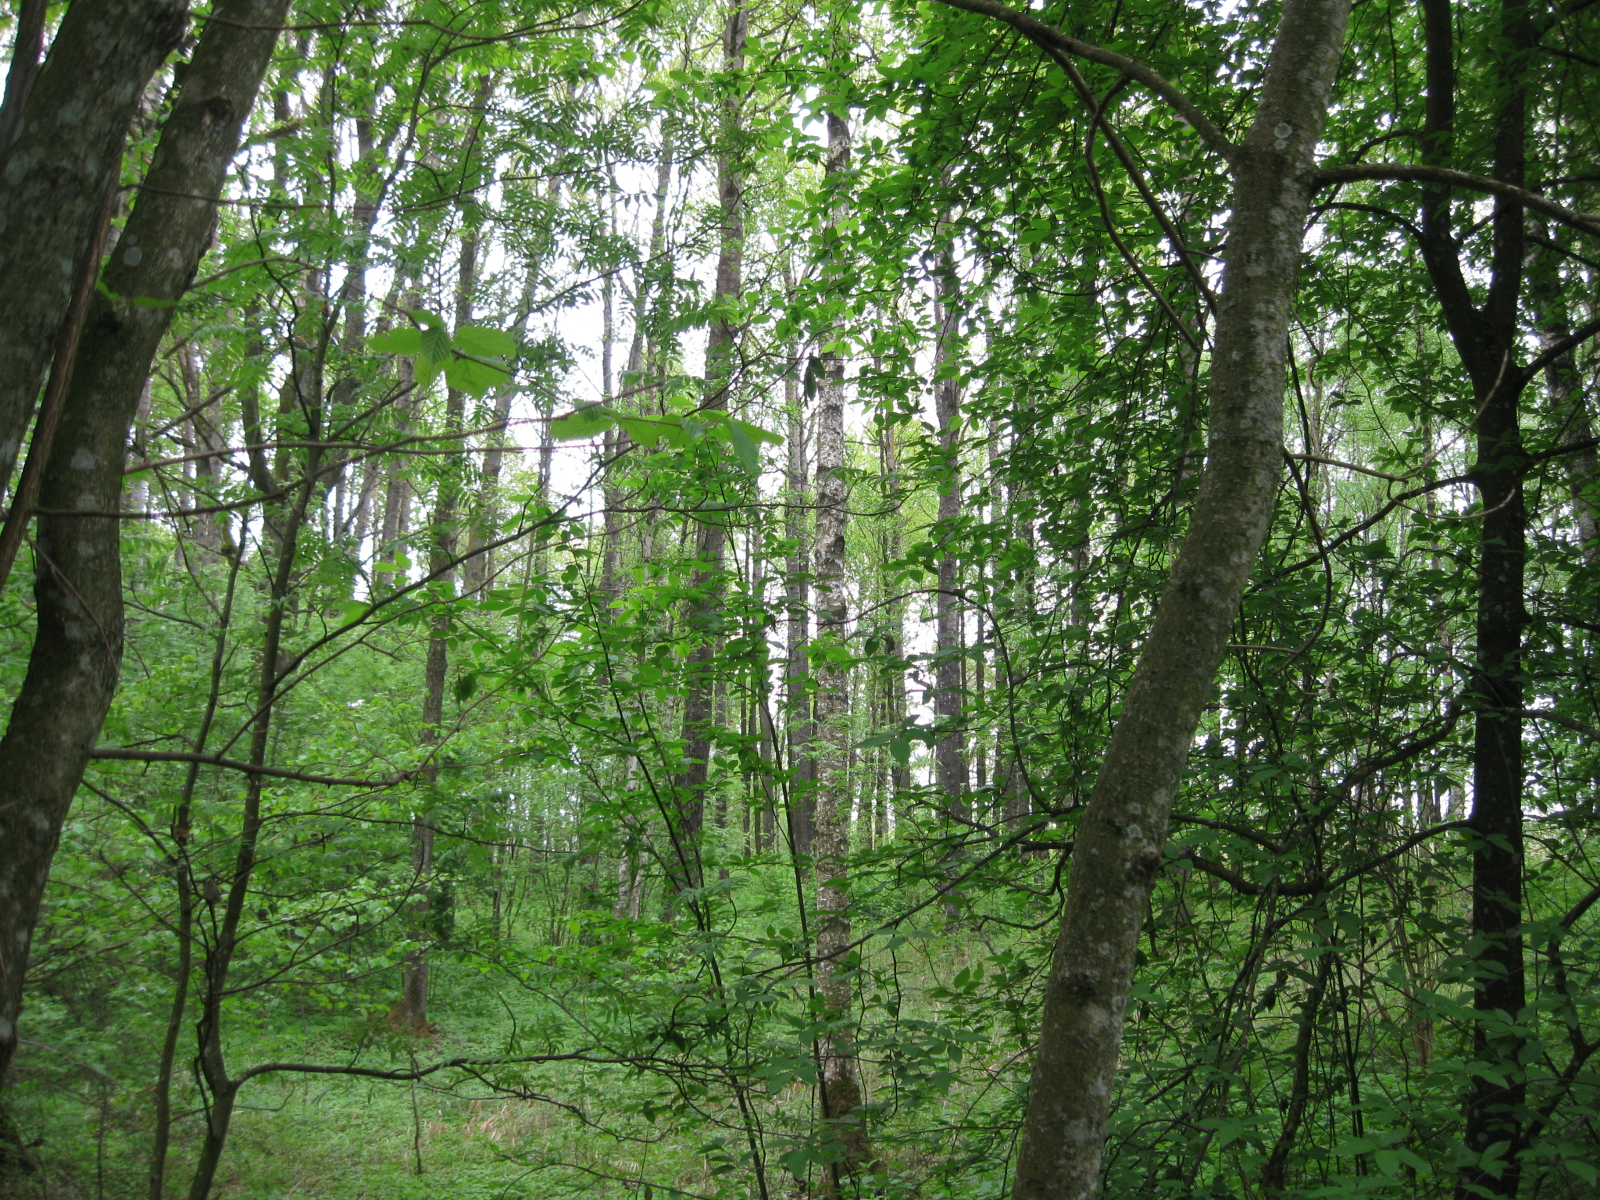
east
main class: Woodland
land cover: Broadleaved woodland
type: non-riverine alder, birch or aspen forest
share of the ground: > 75 %
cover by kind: broadleaved forest trees 90 %, herbaceous plants 10 %
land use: Forestry
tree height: > 5 m
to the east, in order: Broadleaved woodland; Ditches and canals; Broadleaved woodland; Tracks; Dry pulses
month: May
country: LT
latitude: 55.9728
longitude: 24.4051
